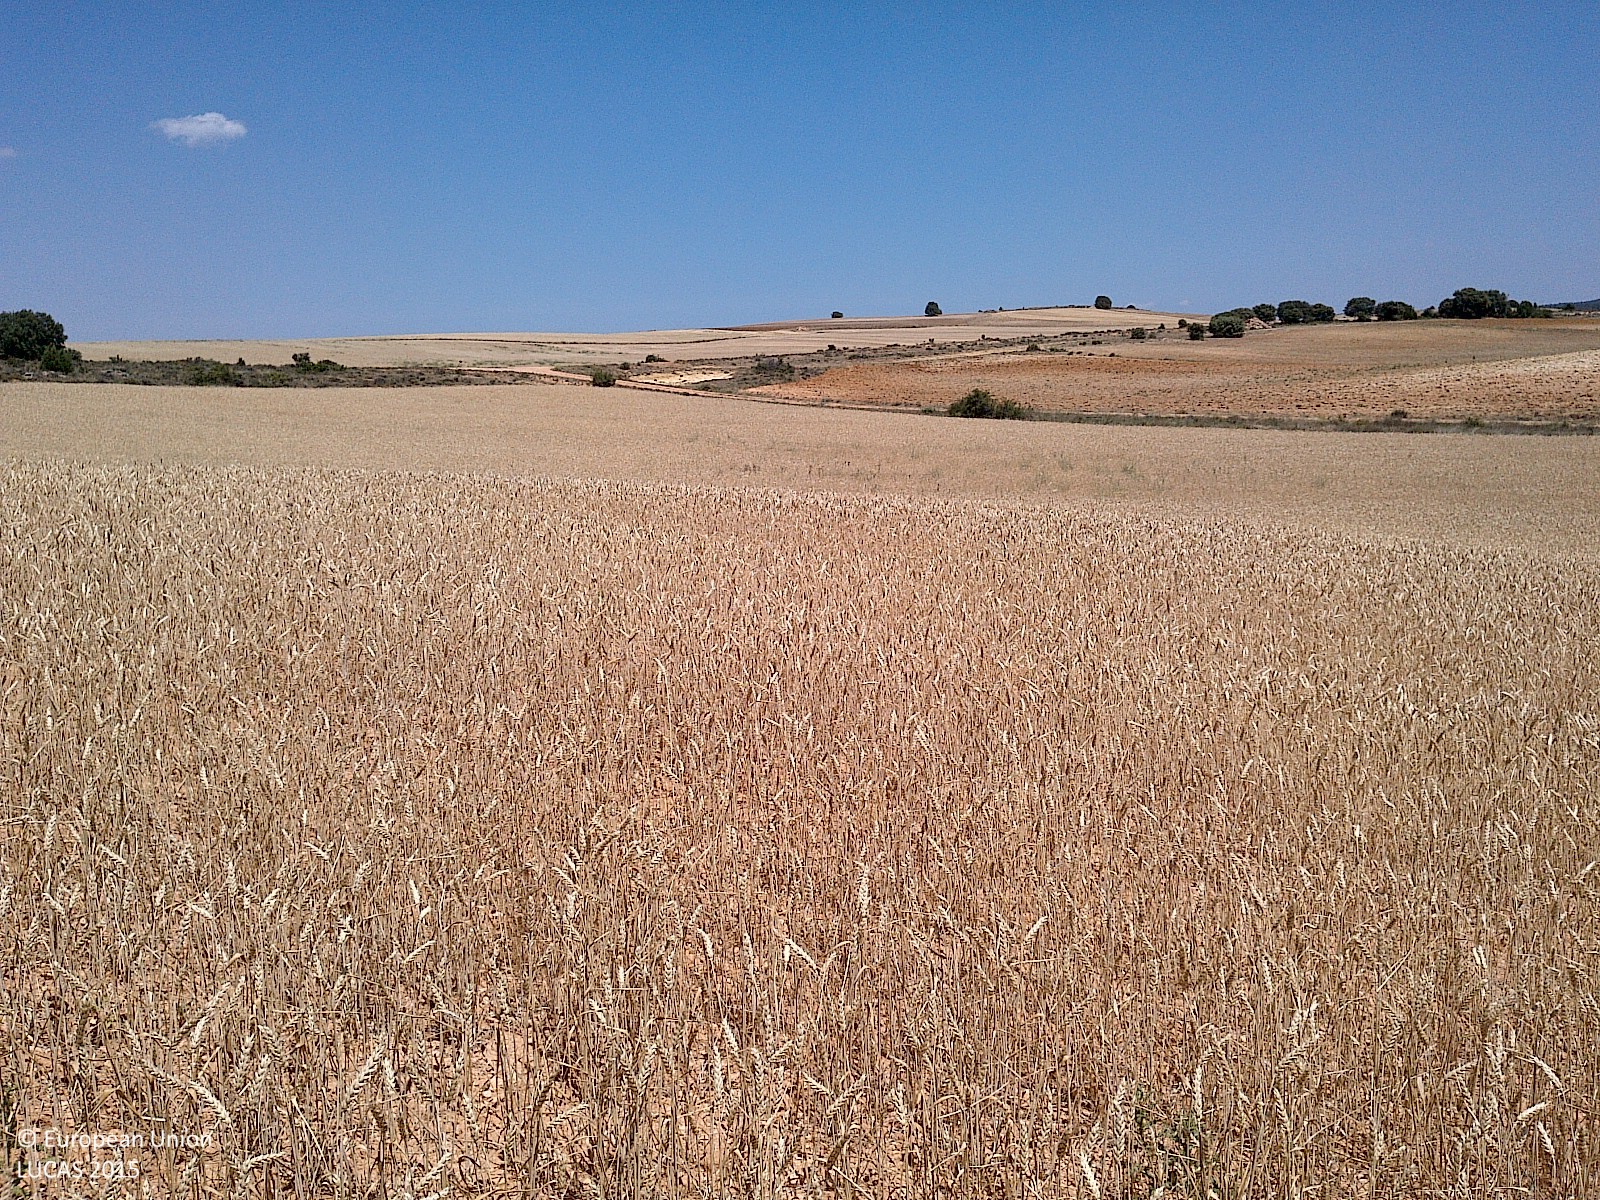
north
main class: Cropland
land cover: Common wheat
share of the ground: > 75 %
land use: Agriculture (excluding fallow land and kitchen gardens)
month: July
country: ES
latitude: 41.7474
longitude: -3.2148
